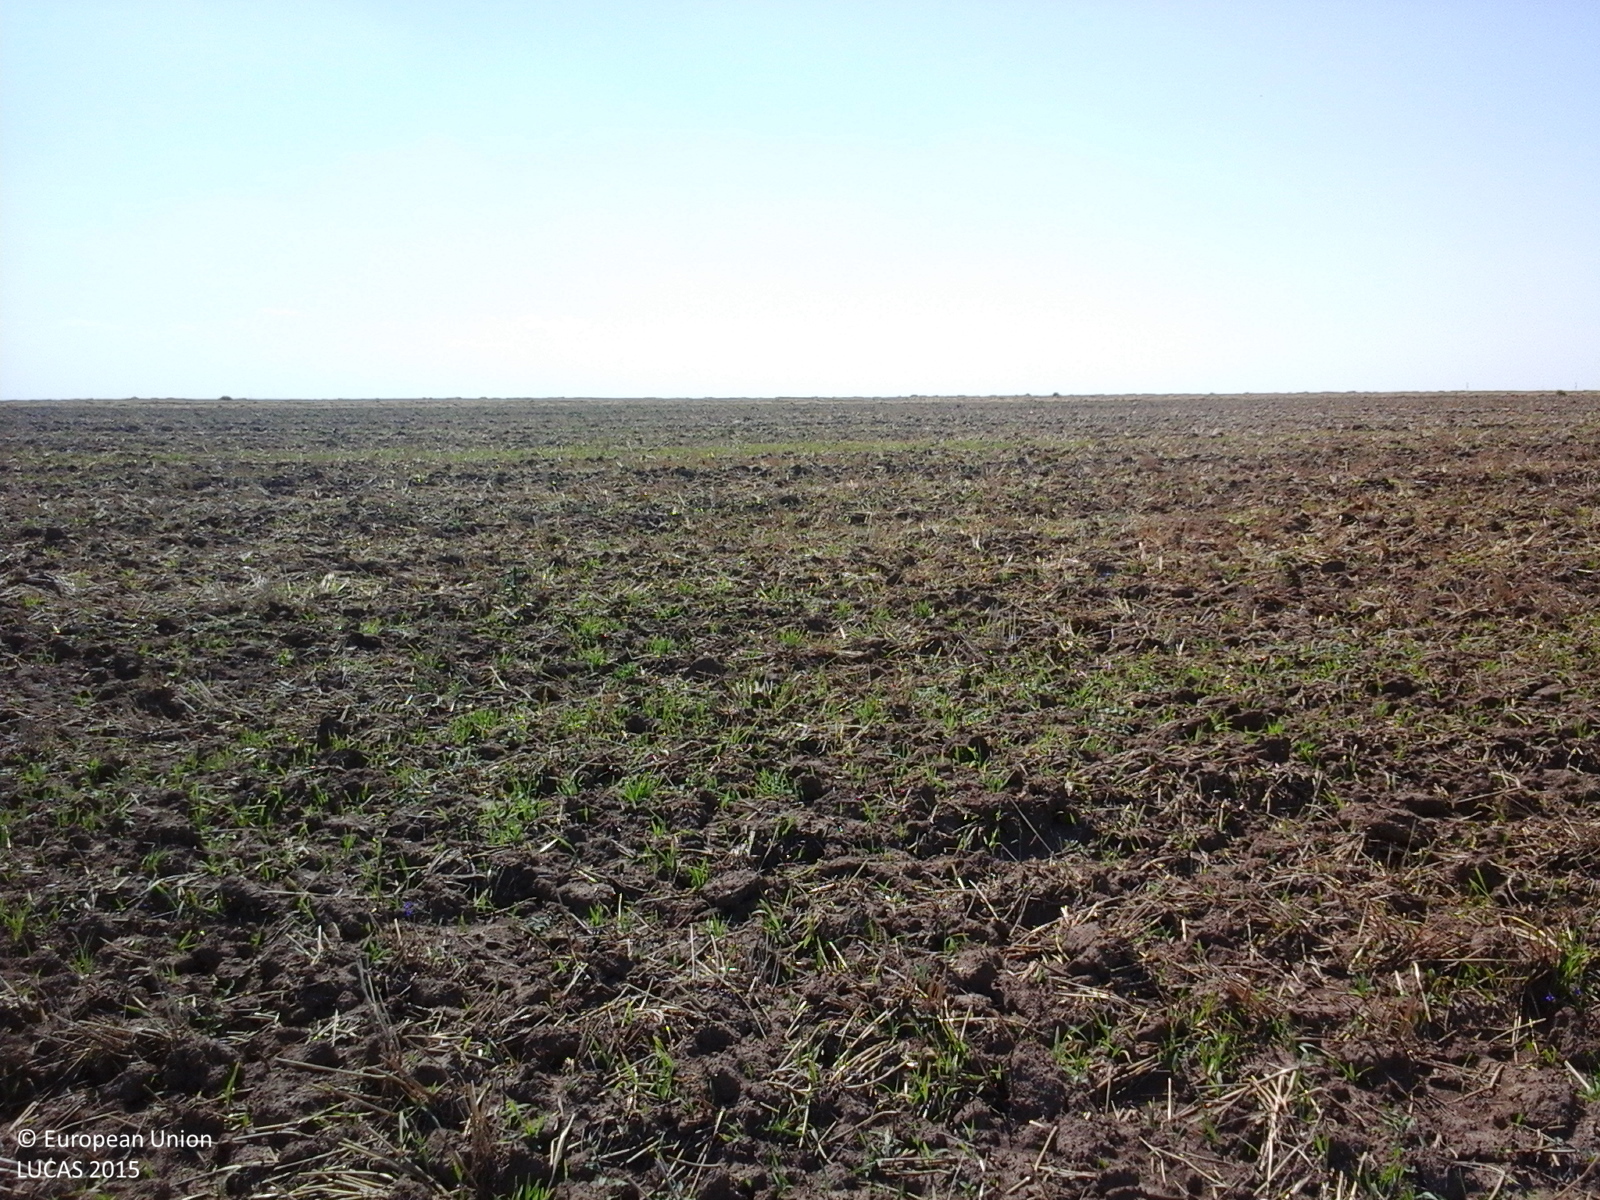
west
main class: Cropland
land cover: Durum wheat
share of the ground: < 10 %
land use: Agriculture (excluding fallow land and kitchen gardens)
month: July
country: RO
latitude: 44.1977
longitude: 24.5462
